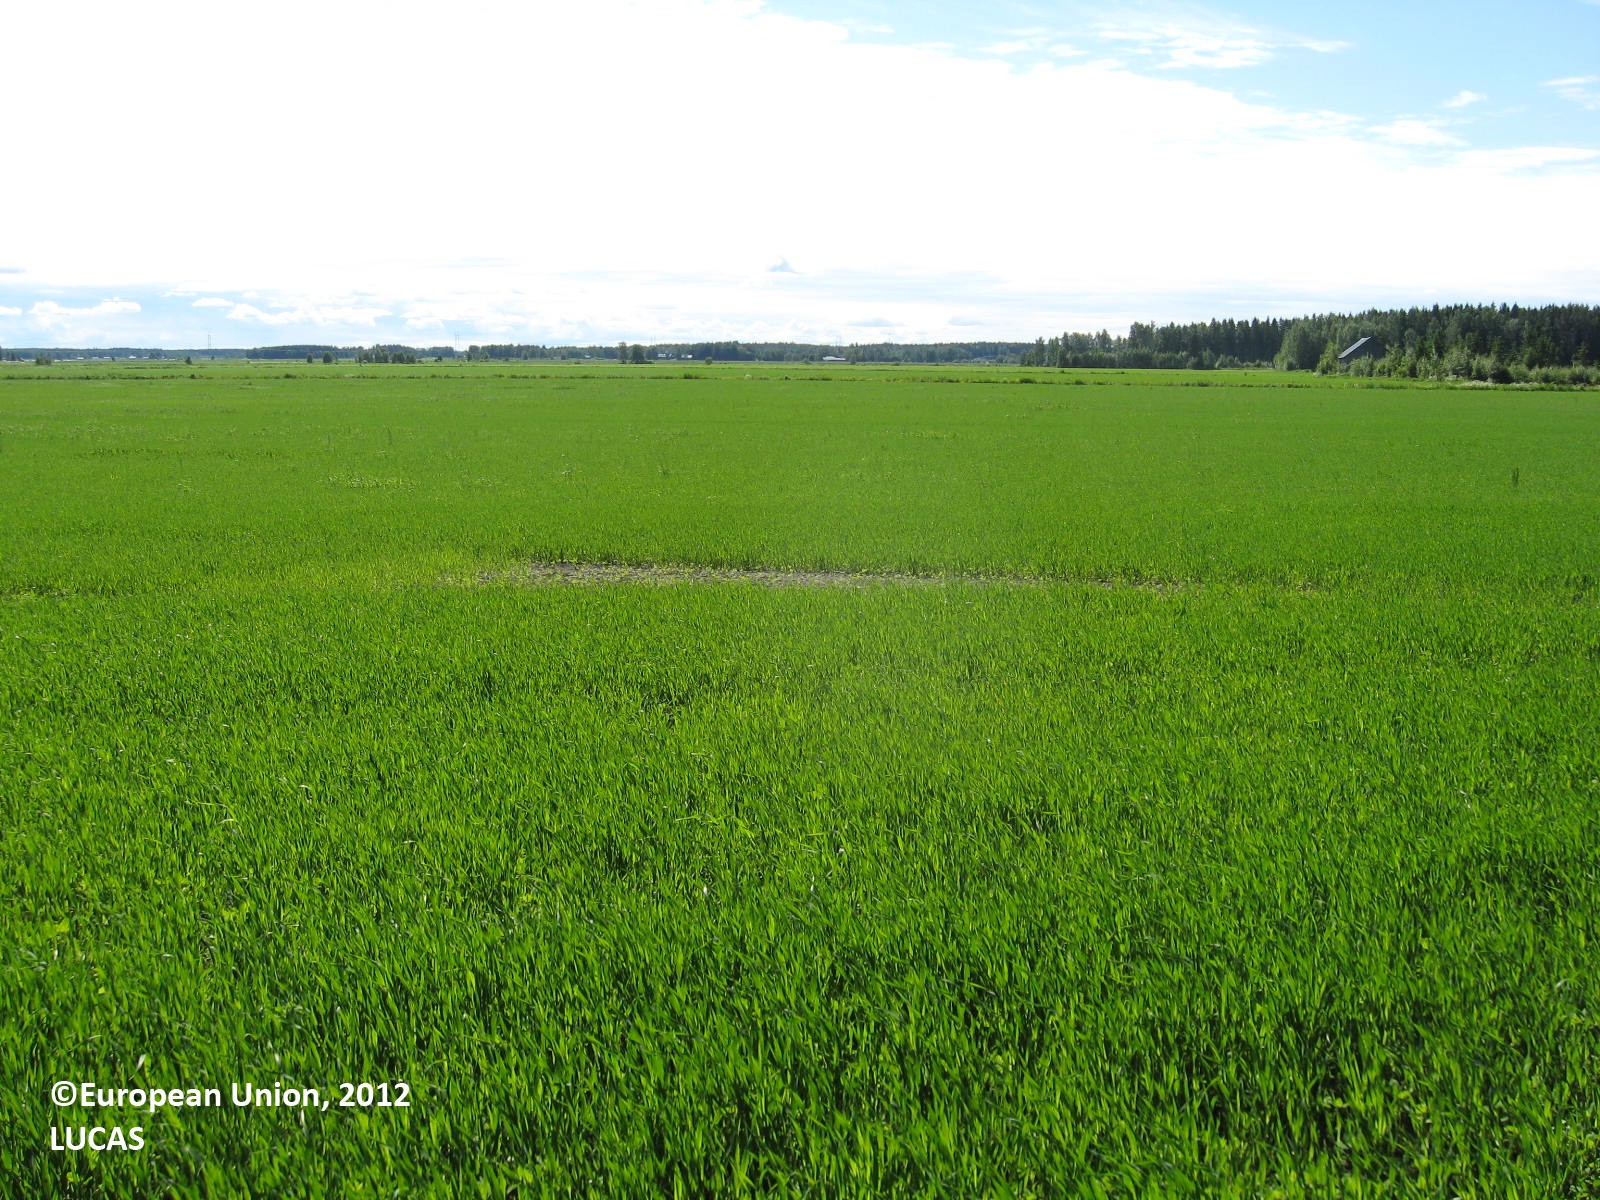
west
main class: Cropland
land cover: Barley
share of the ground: > 75 %
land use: Agriculture (excluding fallow land and kitchen gardens)
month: June
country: FI
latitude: 62.8248
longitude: 22.6751
